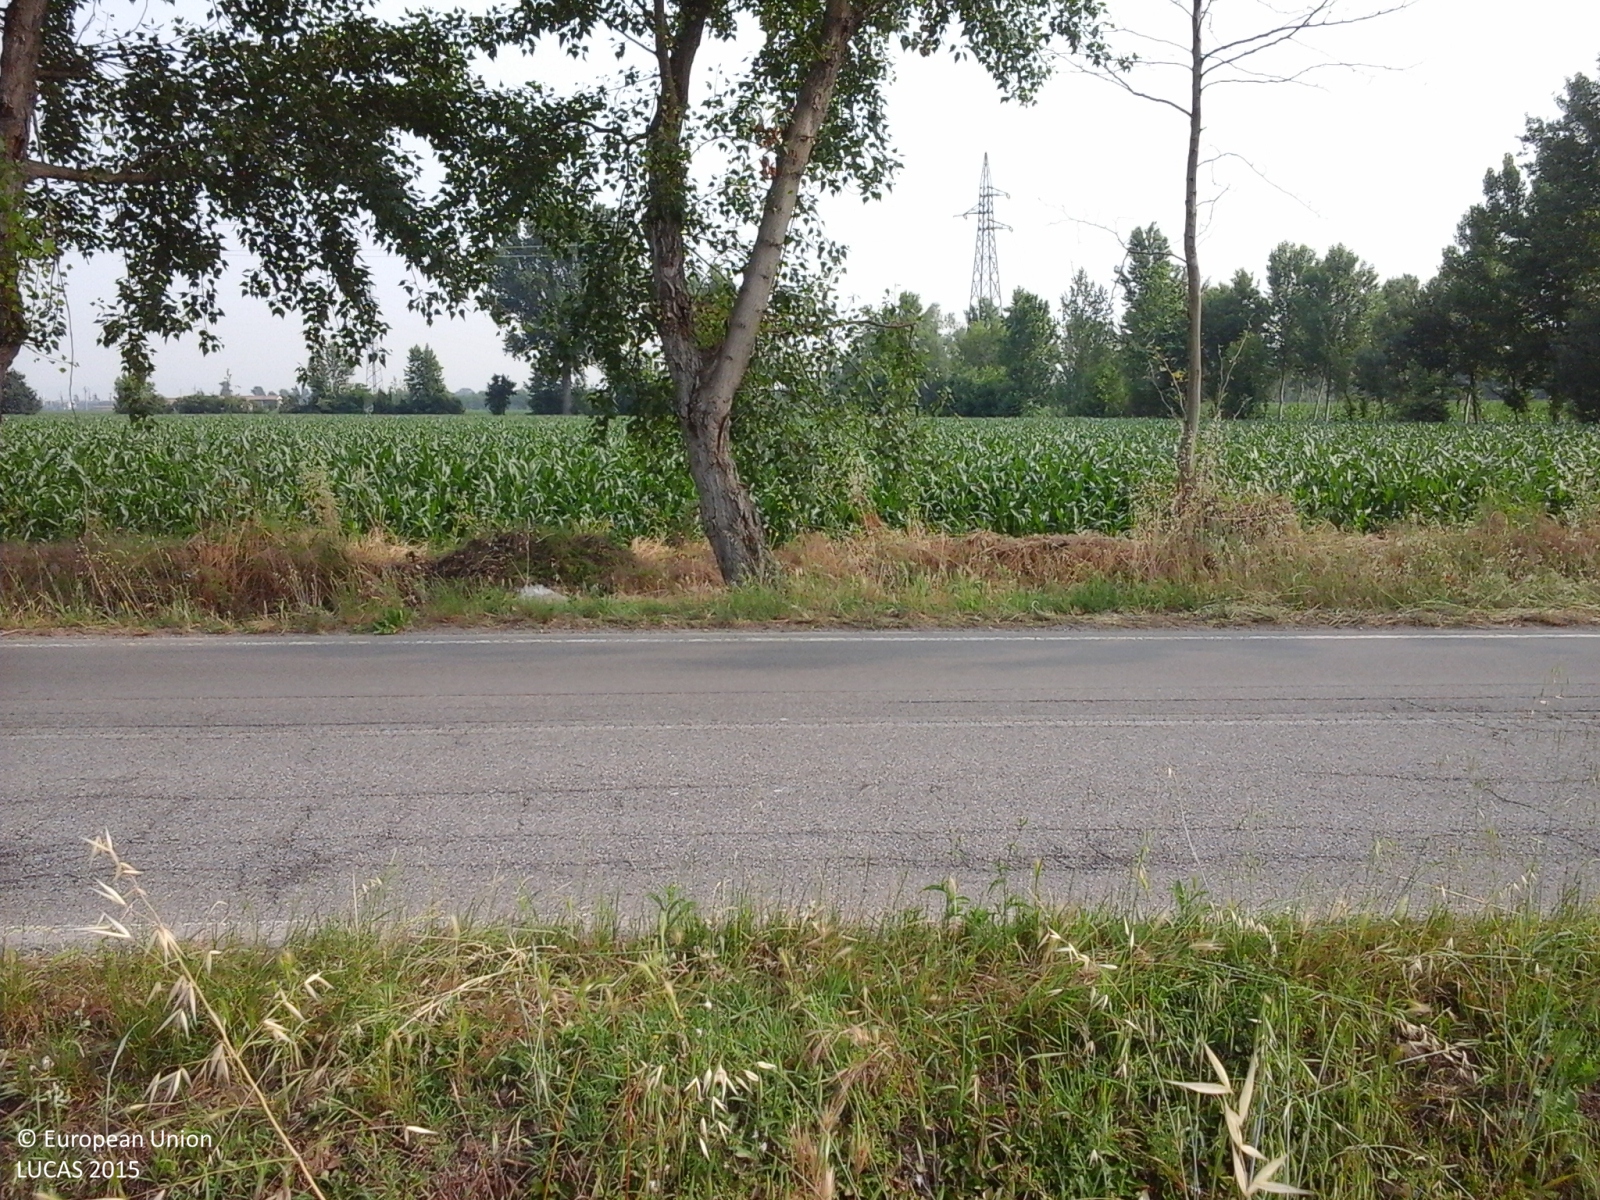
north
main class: Cropland
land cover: Common wheat
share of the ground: > 75 %
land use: Agriculture (excluding fallow land and kitchen gardens)
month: June
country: IT
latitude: 45.4503
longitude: 10.0638
